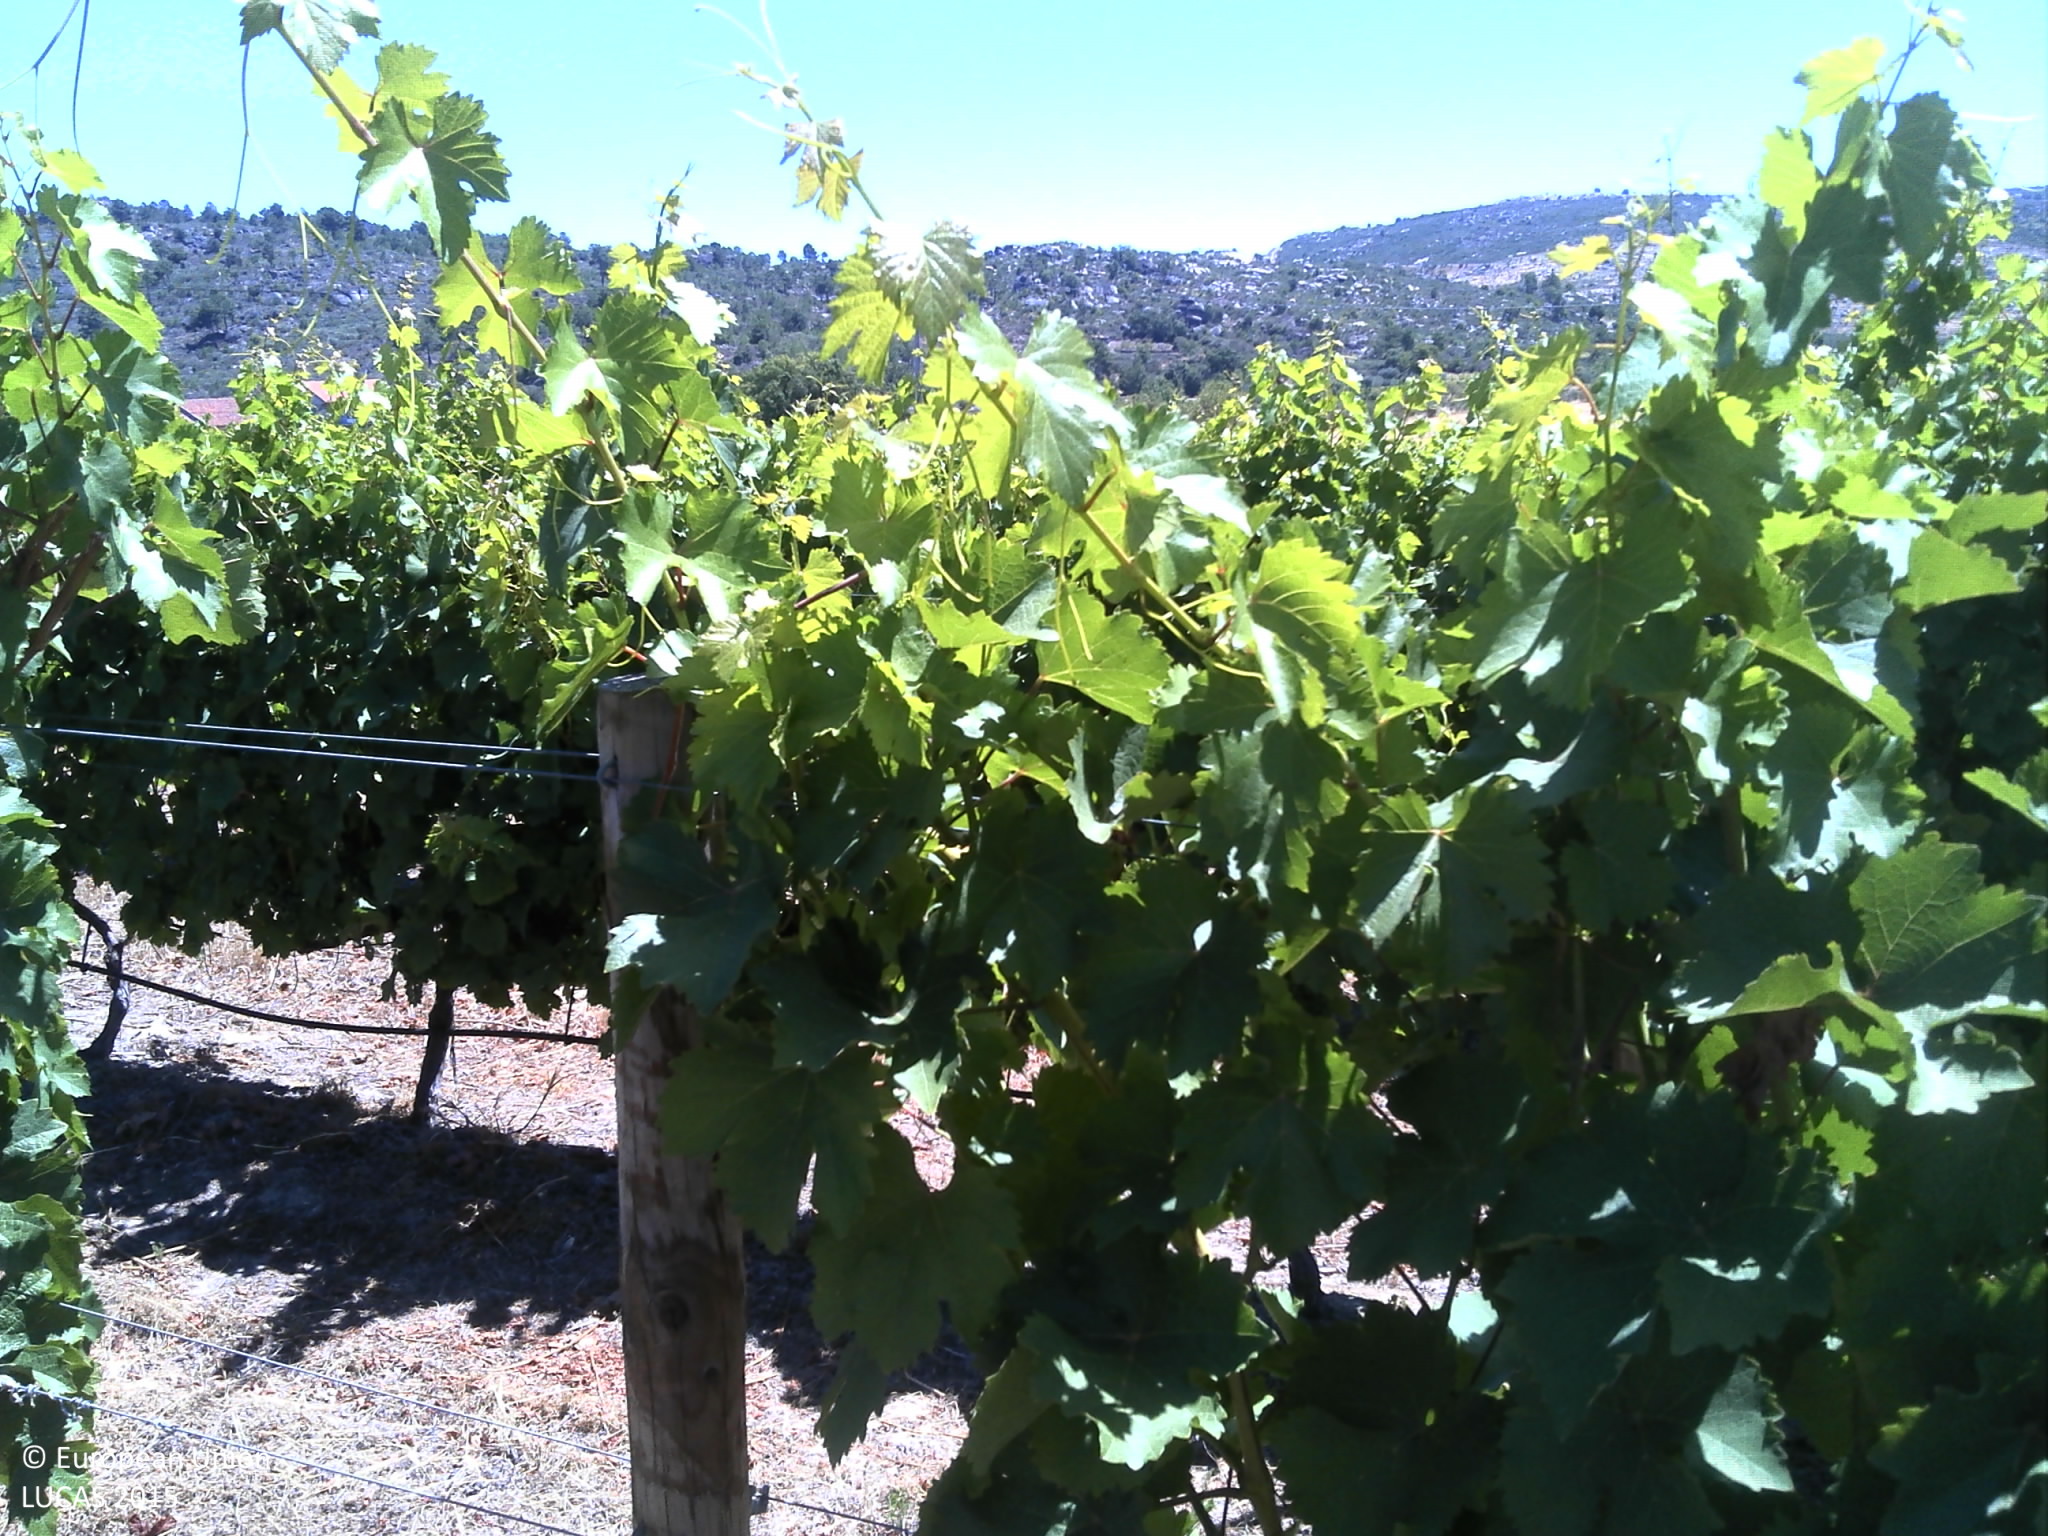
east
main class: Cropland
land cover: Vineyards
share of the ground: < 10 %
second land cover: Other bare soil
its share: > 75 %
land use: Agriculture (excluding fallow land and kitchen gardens)
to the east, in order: Vineyards; Other bare soil; Vineyards; Tracks; Dry stone walls; Grassland without tree/shrub cover; Artificial constructions; Electric lines; Grass margins; Paved roads, cycling and walking lanes; Artificial constructions; Fences; Grassland without tree/shrub cover; Fences; Other bare soil; Electric lines; Other bare soil; Fences; Dry stone walls; Olive groves; Other bare soil; Dry stone walls; Spontaneously vegetated surfaces; Other fresh vegetables; Maize; Other fresh vegetables; Vineyards; Tracks; Dry stone walls; Groves; Grassland without tree/shrub cover; Fences; Groves; Grassland with sparse tree/shrub cover
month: July
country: PT
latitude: 41.2770
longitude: -7.3227
